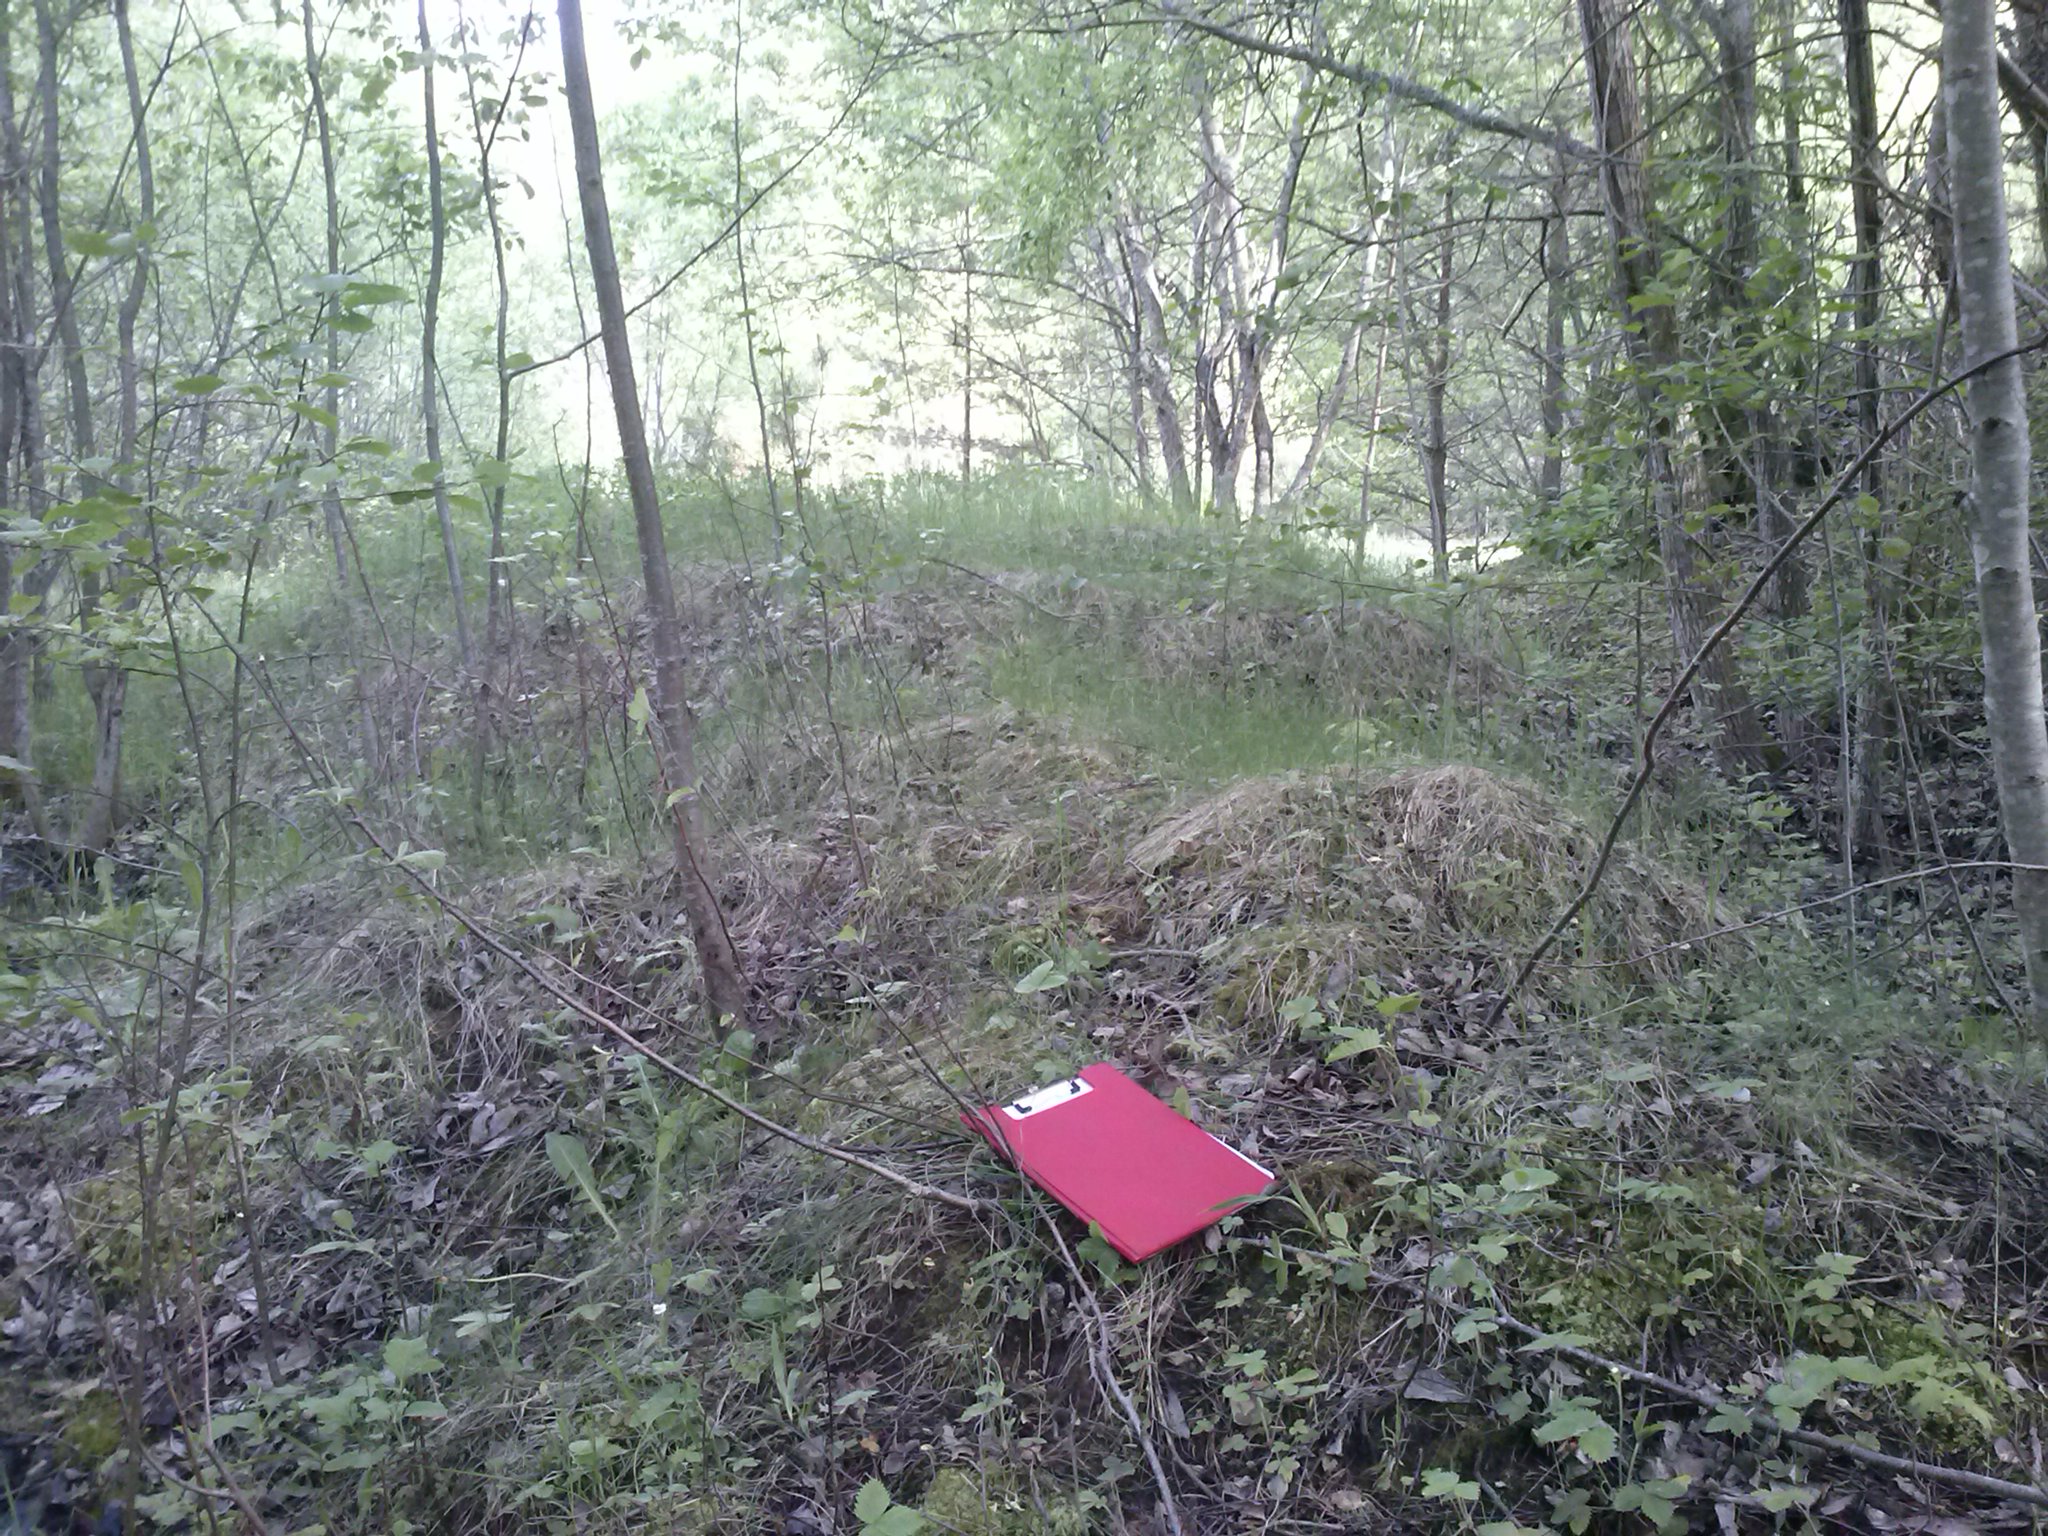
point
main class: Woodland
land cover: Broadleaved woodland
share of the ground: > 75 %
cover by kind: broadleaved forest trees 100 %
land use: Forestry
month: May
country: LV
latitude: 56.3137
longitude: 27.7950
